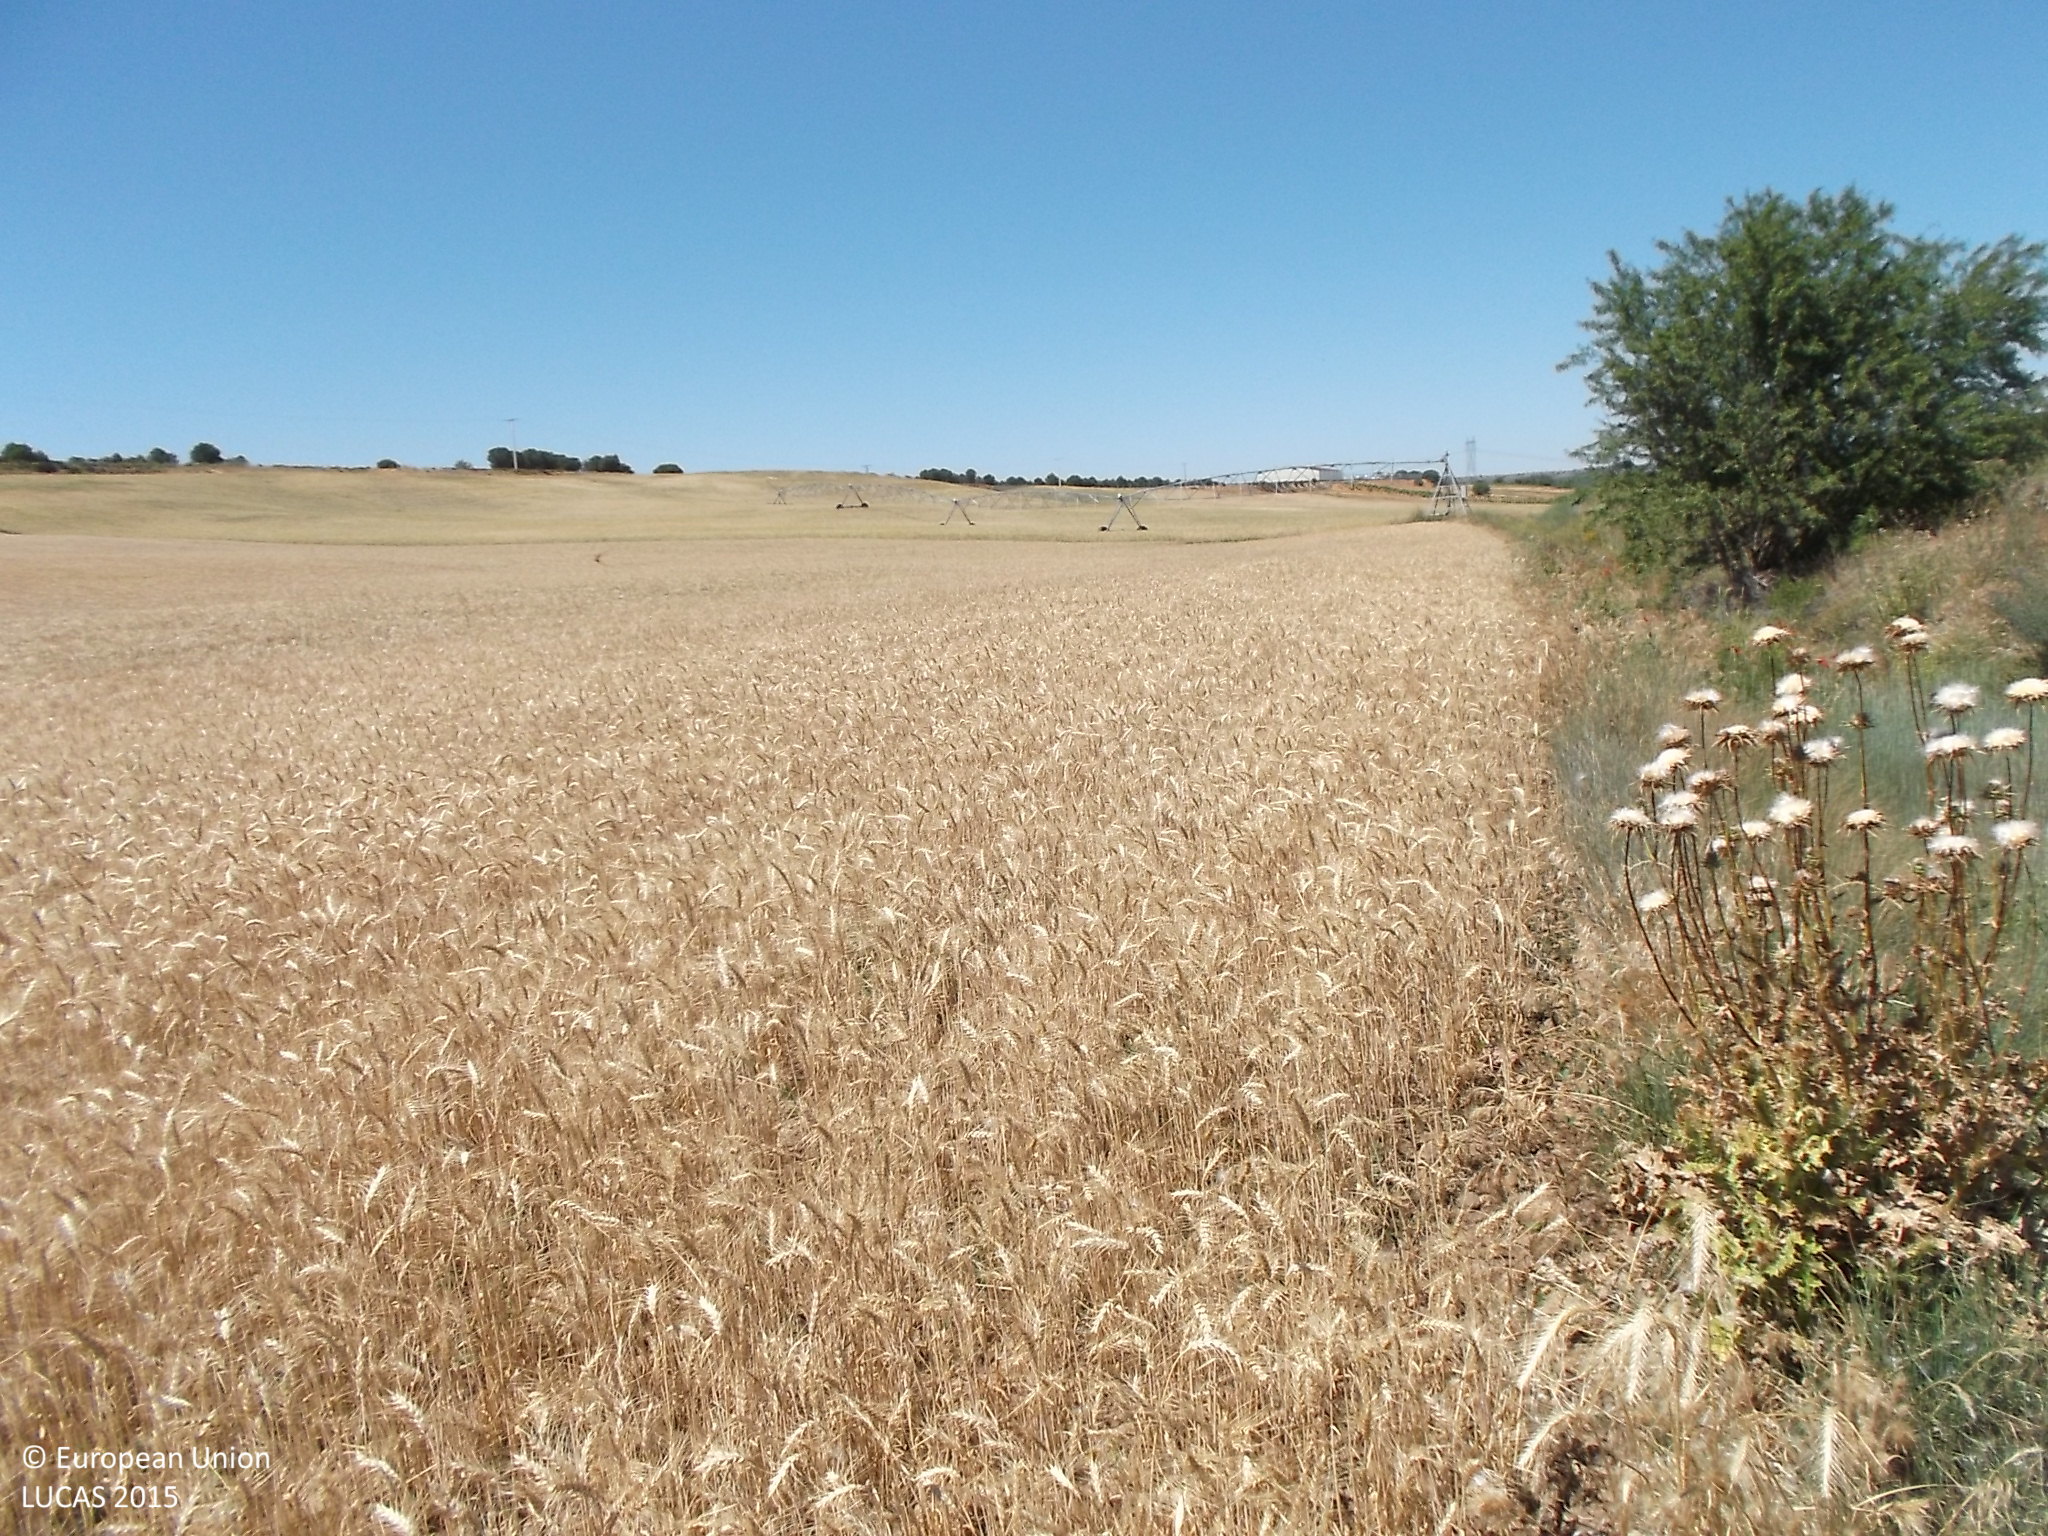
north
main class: Cropland
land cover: Common wheat
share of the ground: > 75 %
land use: Agriculture (excluding fallow land and kitchen gardens)
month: June
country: ES
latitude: 41.4411
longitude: -5.3376
